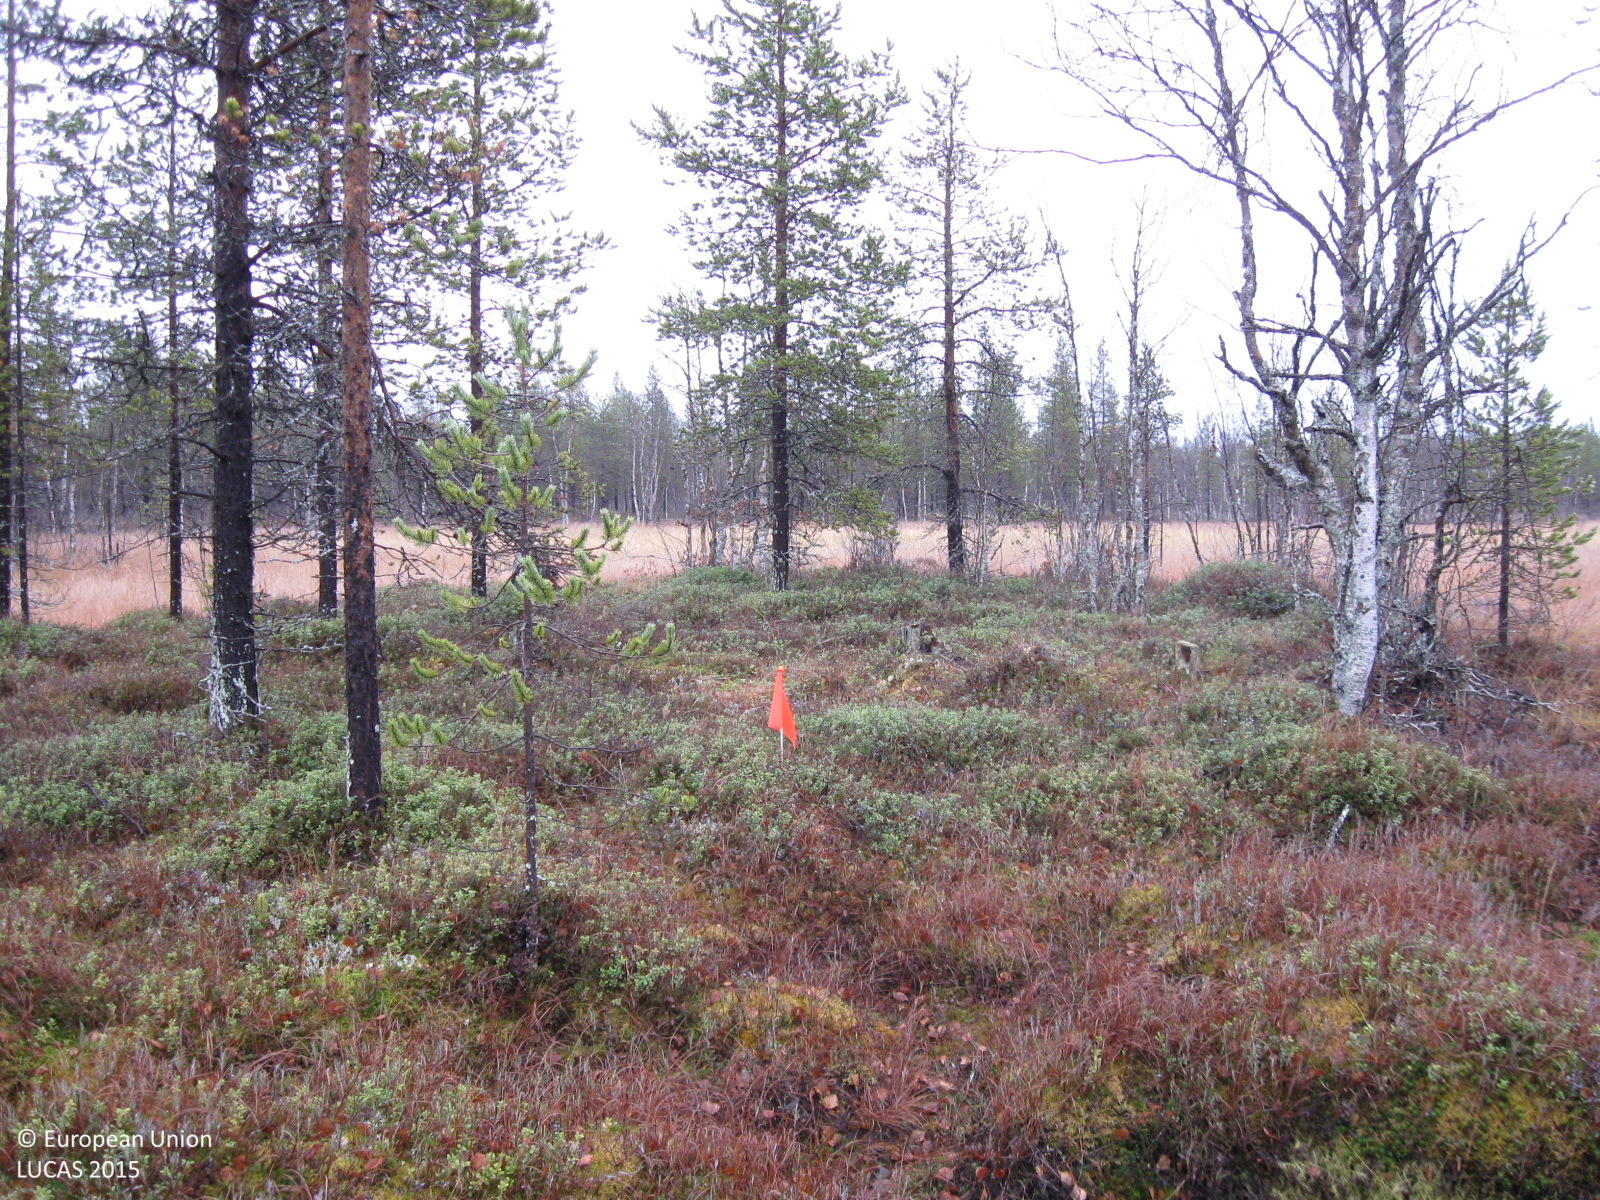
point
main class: Woodland
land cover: Pine dominated mixed woodland
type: mire and swamp forests
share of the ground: 25 - 50 %
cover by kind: herbaceous plants 35 %, shrubs 20 %, coniferous forest trees 15 %, broadleaved forest trees 15 %, lichens and mosses 15 %
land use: Semi-natural and natural areas not in use
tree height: > 5 m
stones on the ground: < 10 %
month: October
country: SE
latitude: 66.7399
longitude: 21.0074
